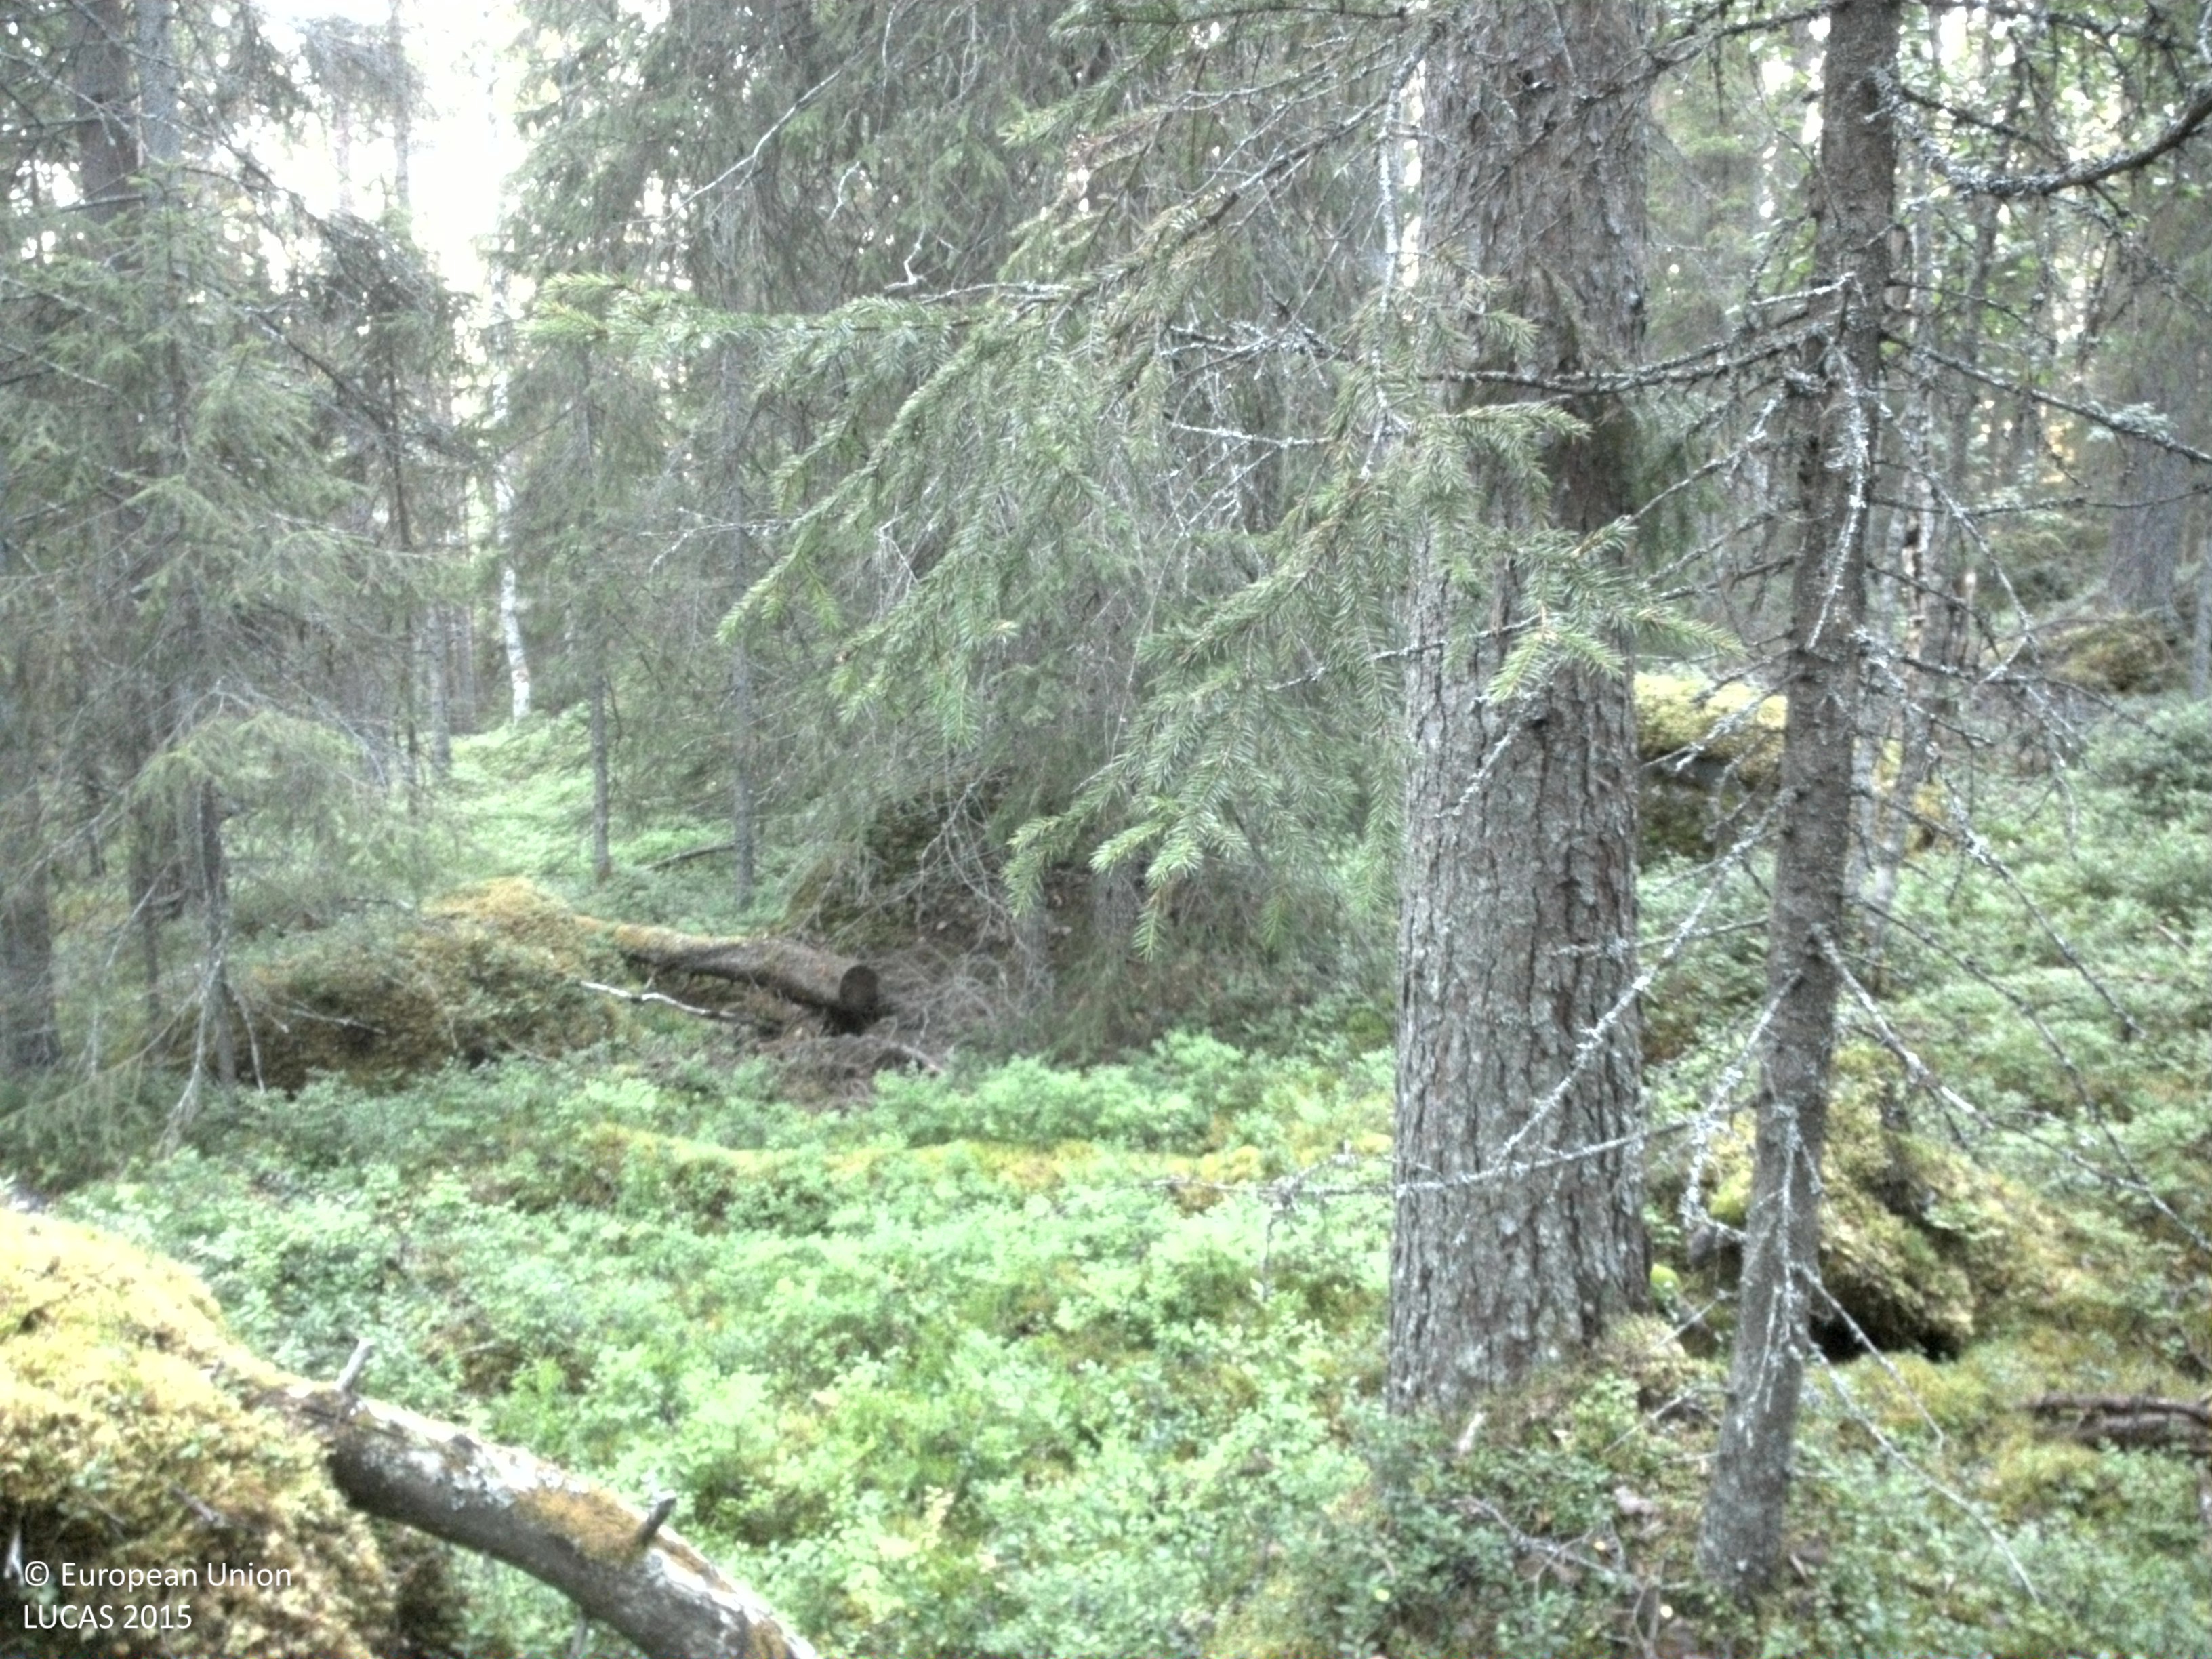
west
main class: Woodland
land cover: Other coniferous woodland
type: boreal forest
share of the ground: 50 - 75 %
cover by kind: coniferous forest trees 50 %, shrubs 25 %, lichens and mosses 15 %, broadleaved forest trees 10 %
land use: Forestry
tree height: > 5 m
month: August
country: SE
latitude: 64.5449
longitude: 16.7444
